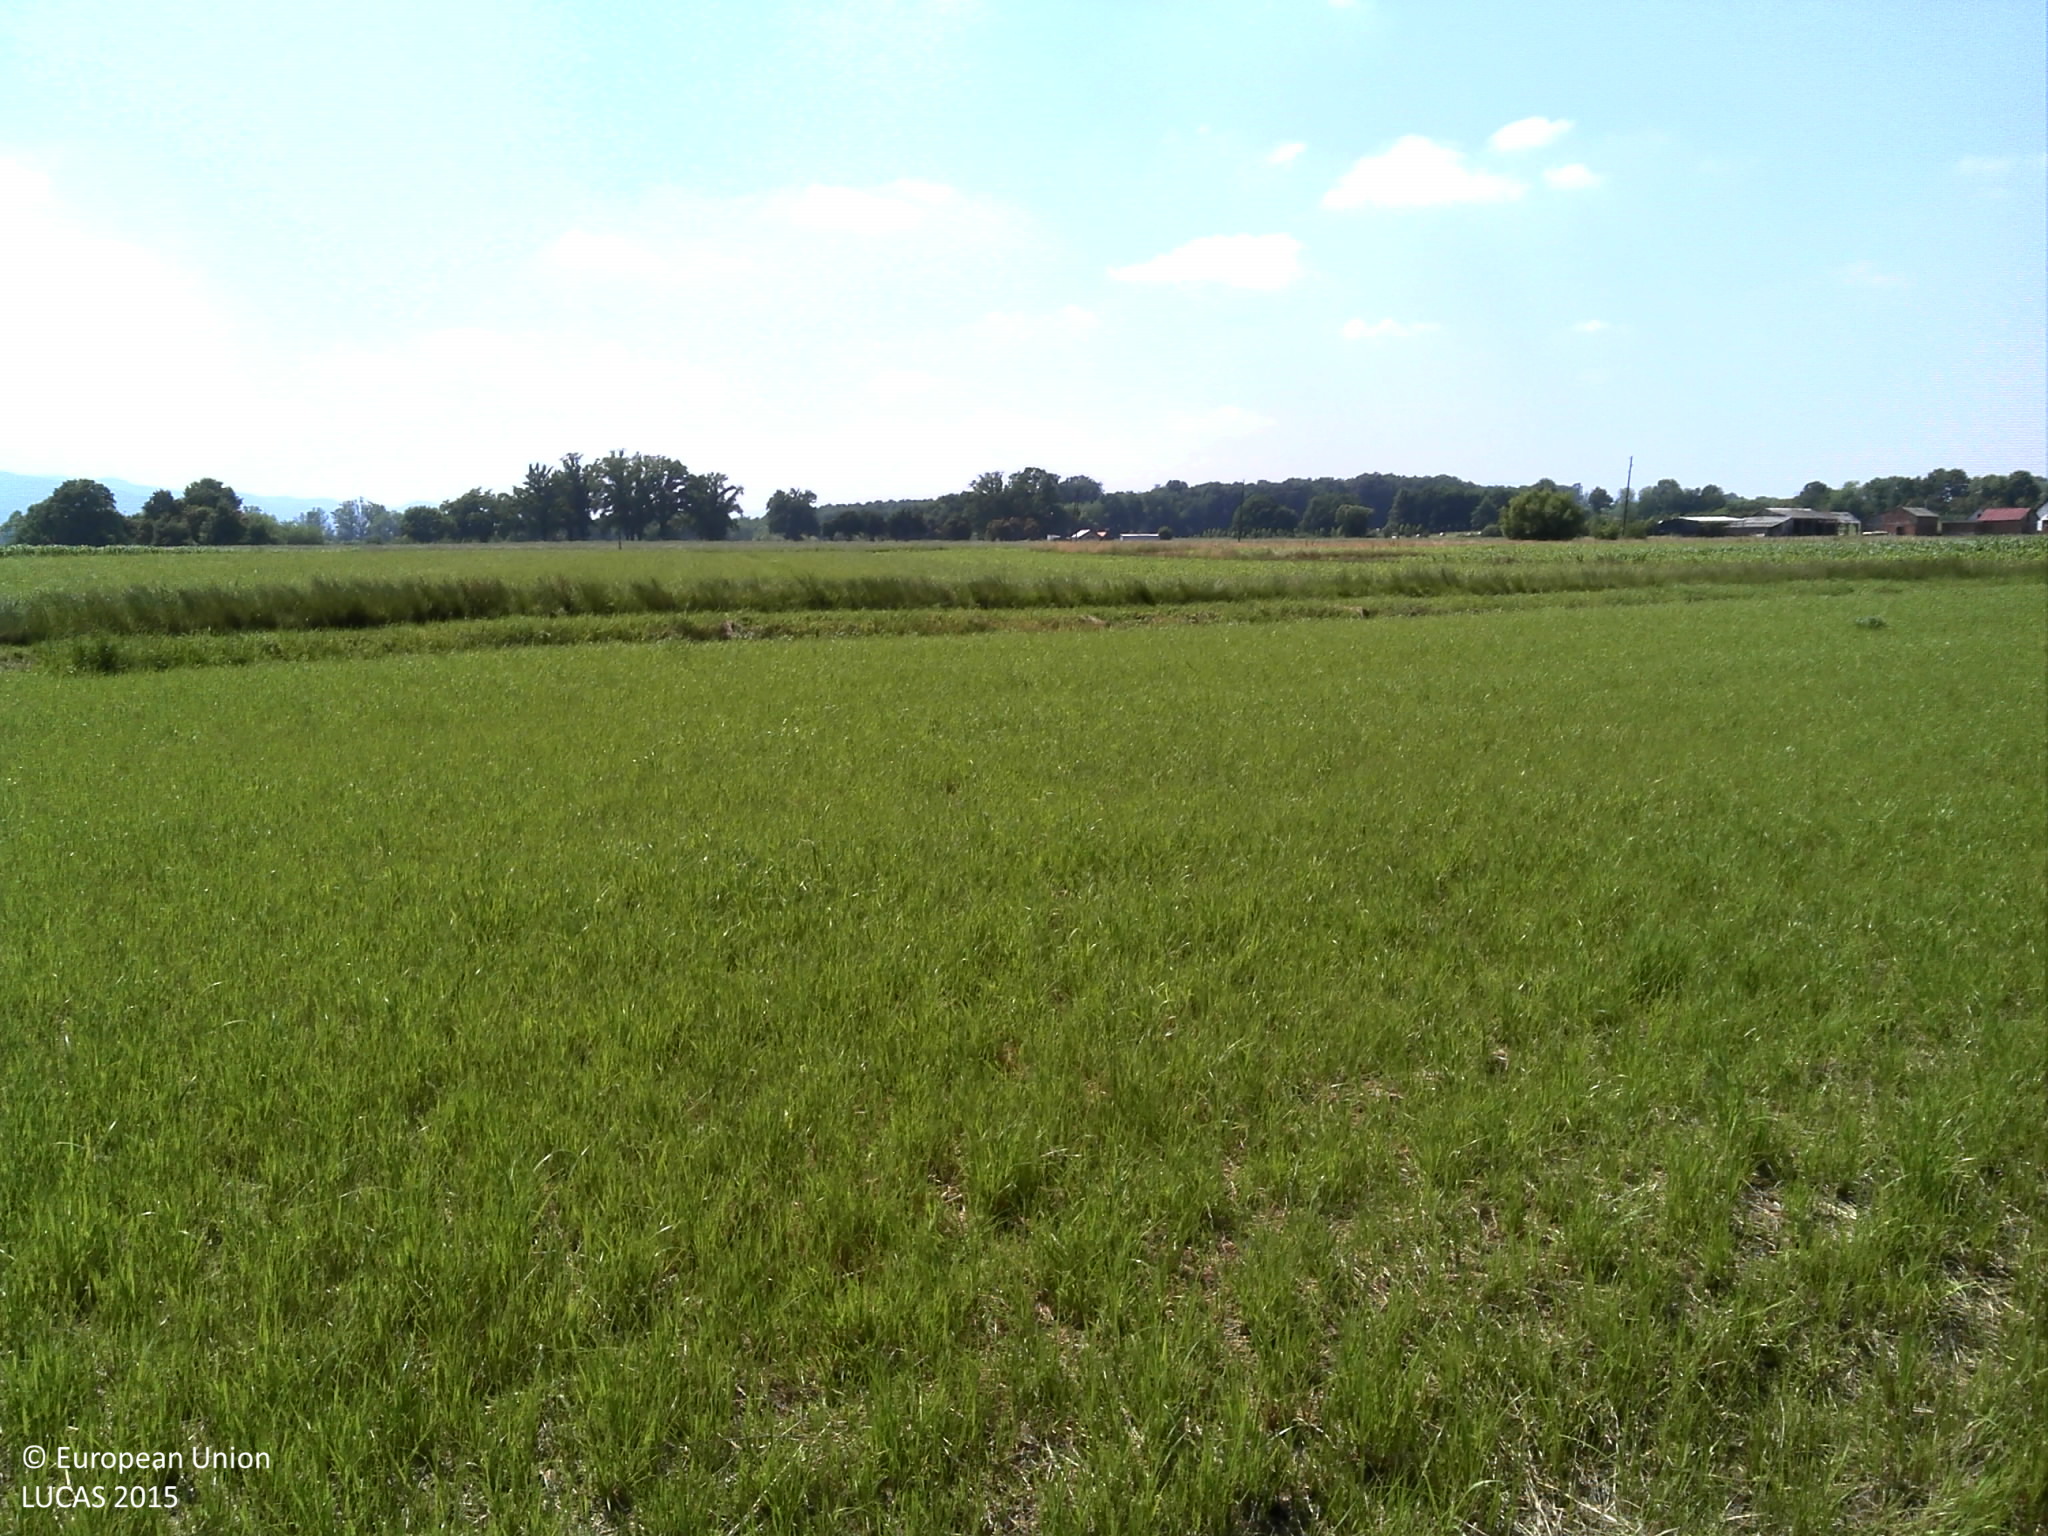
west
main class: Grassland
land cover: Grassland without tree/shrub cover
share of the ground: > 75 %
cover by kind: herbaceous plants 100 %
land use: Abandoned areas
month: June
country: HR
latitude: 45.3355
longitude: 17.6451
